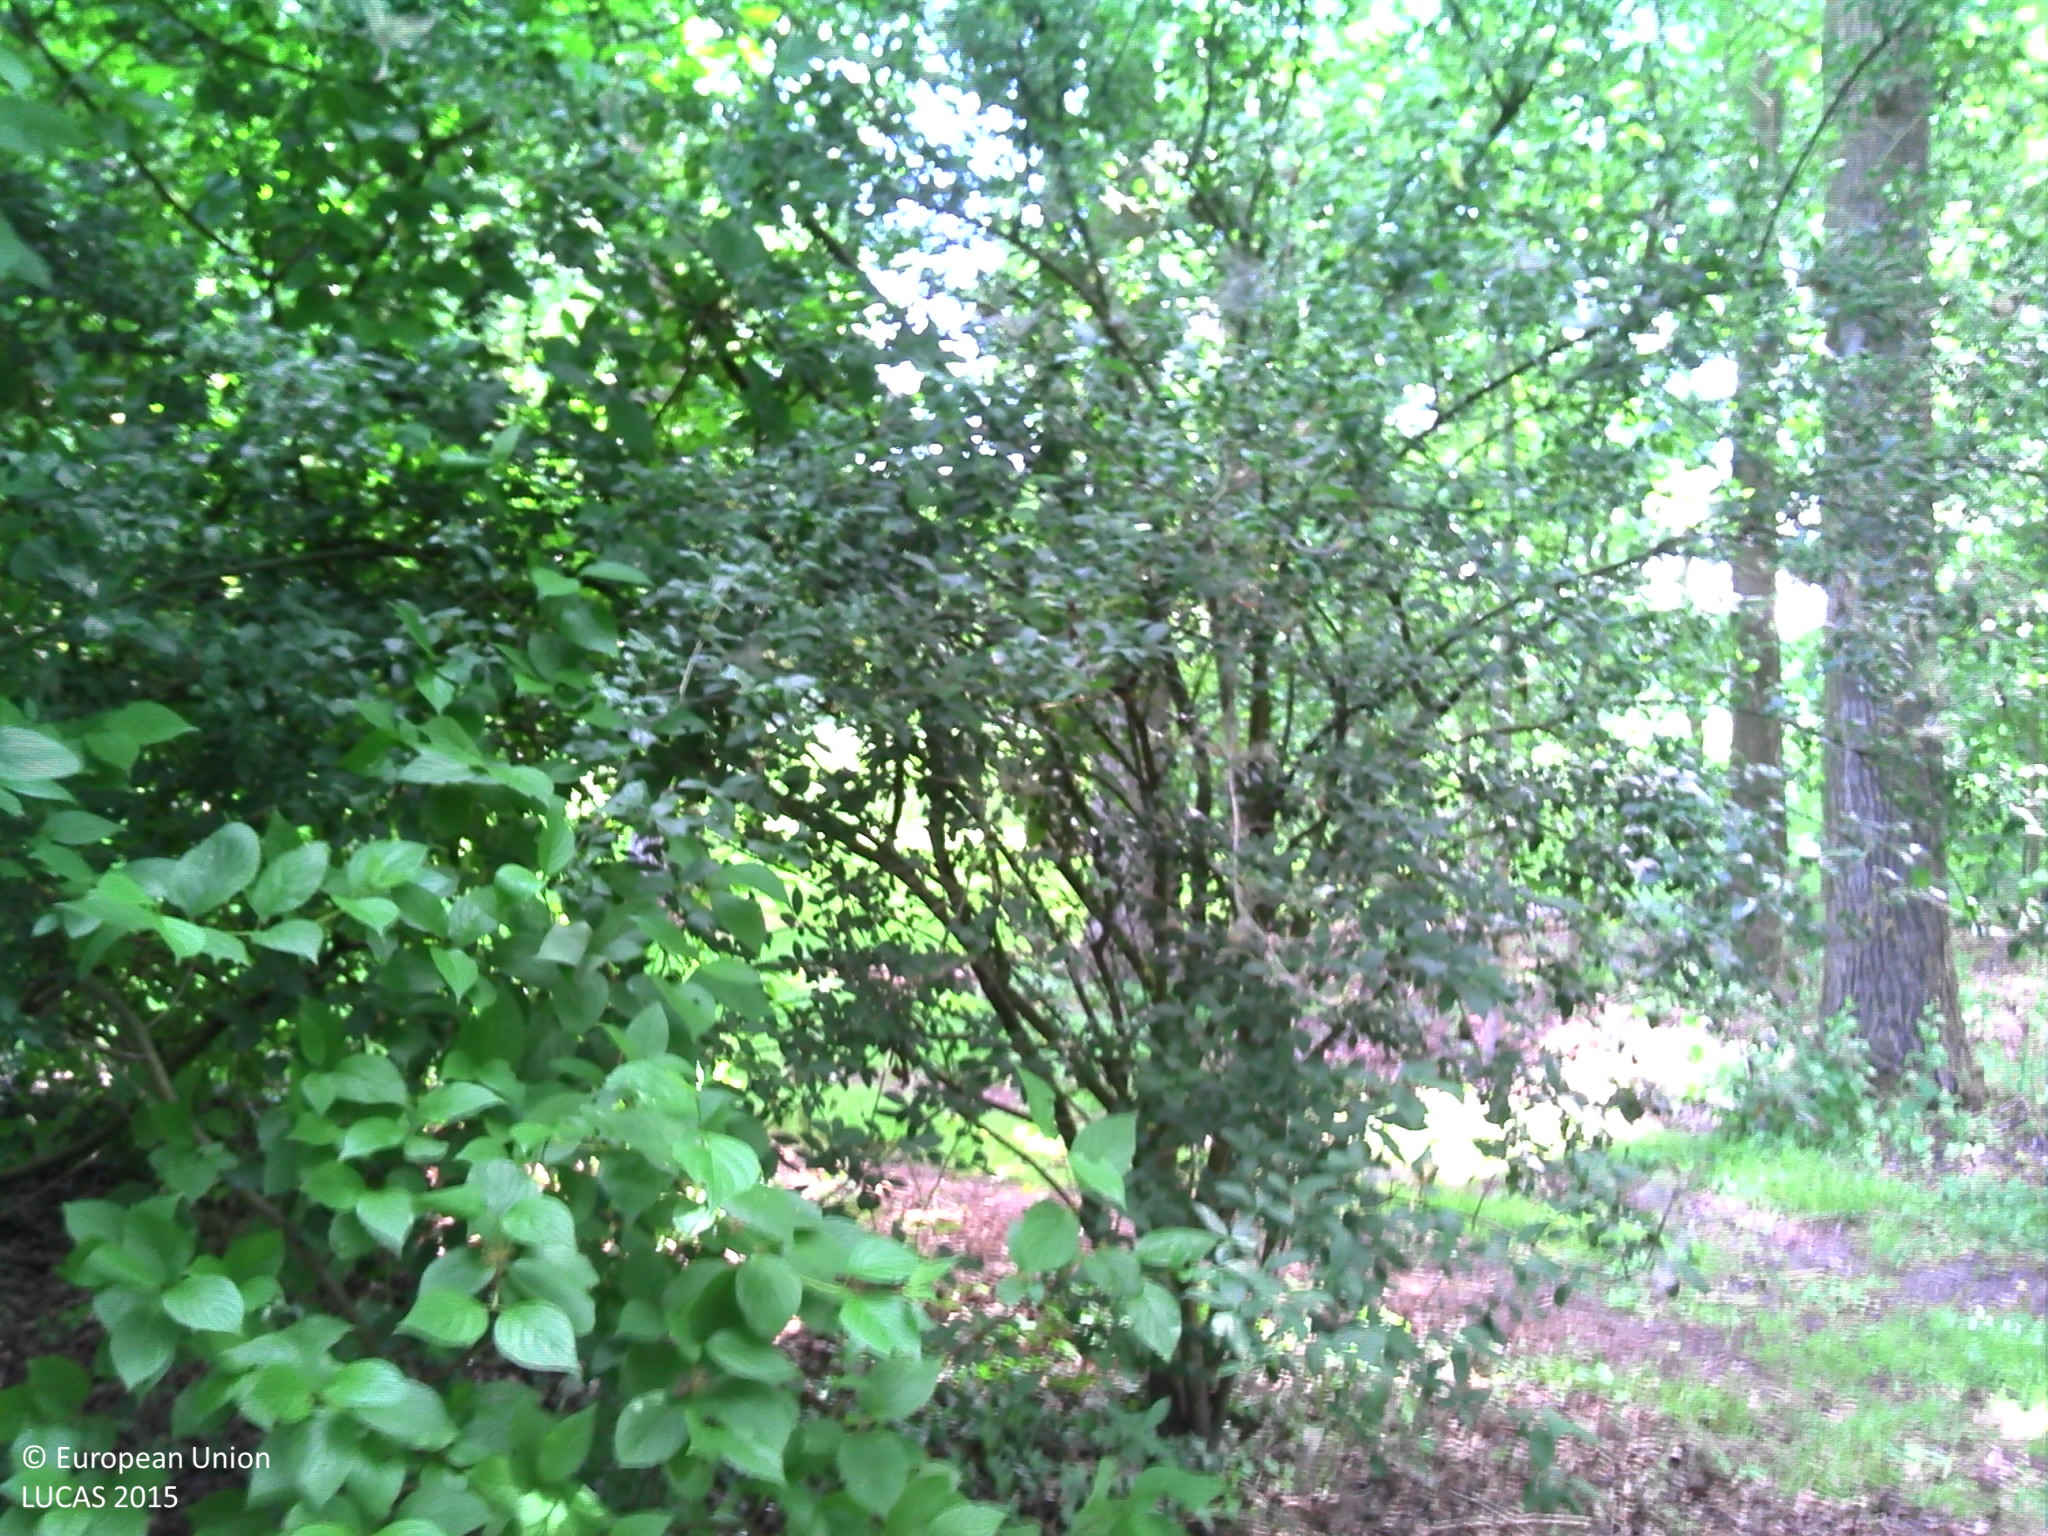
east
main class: Woodland
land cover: Broadleaved woodland
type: mesophytic deciduous forest
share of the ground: > 75 %
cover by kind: broadleaved forest trees 100 %
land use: Residential
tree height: > 5 m
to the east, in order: Broadleaved woodland; Rivers and streams; Broadleaved woodland; Tracks; Fences; Potatoes; Sugar beet; Broadleaved woodland; Fences; Broadleaved woodland; Inland fresh water bodies; Broadleaved woodland
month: June
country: BE
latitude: 50.8935
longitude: 3.6948
